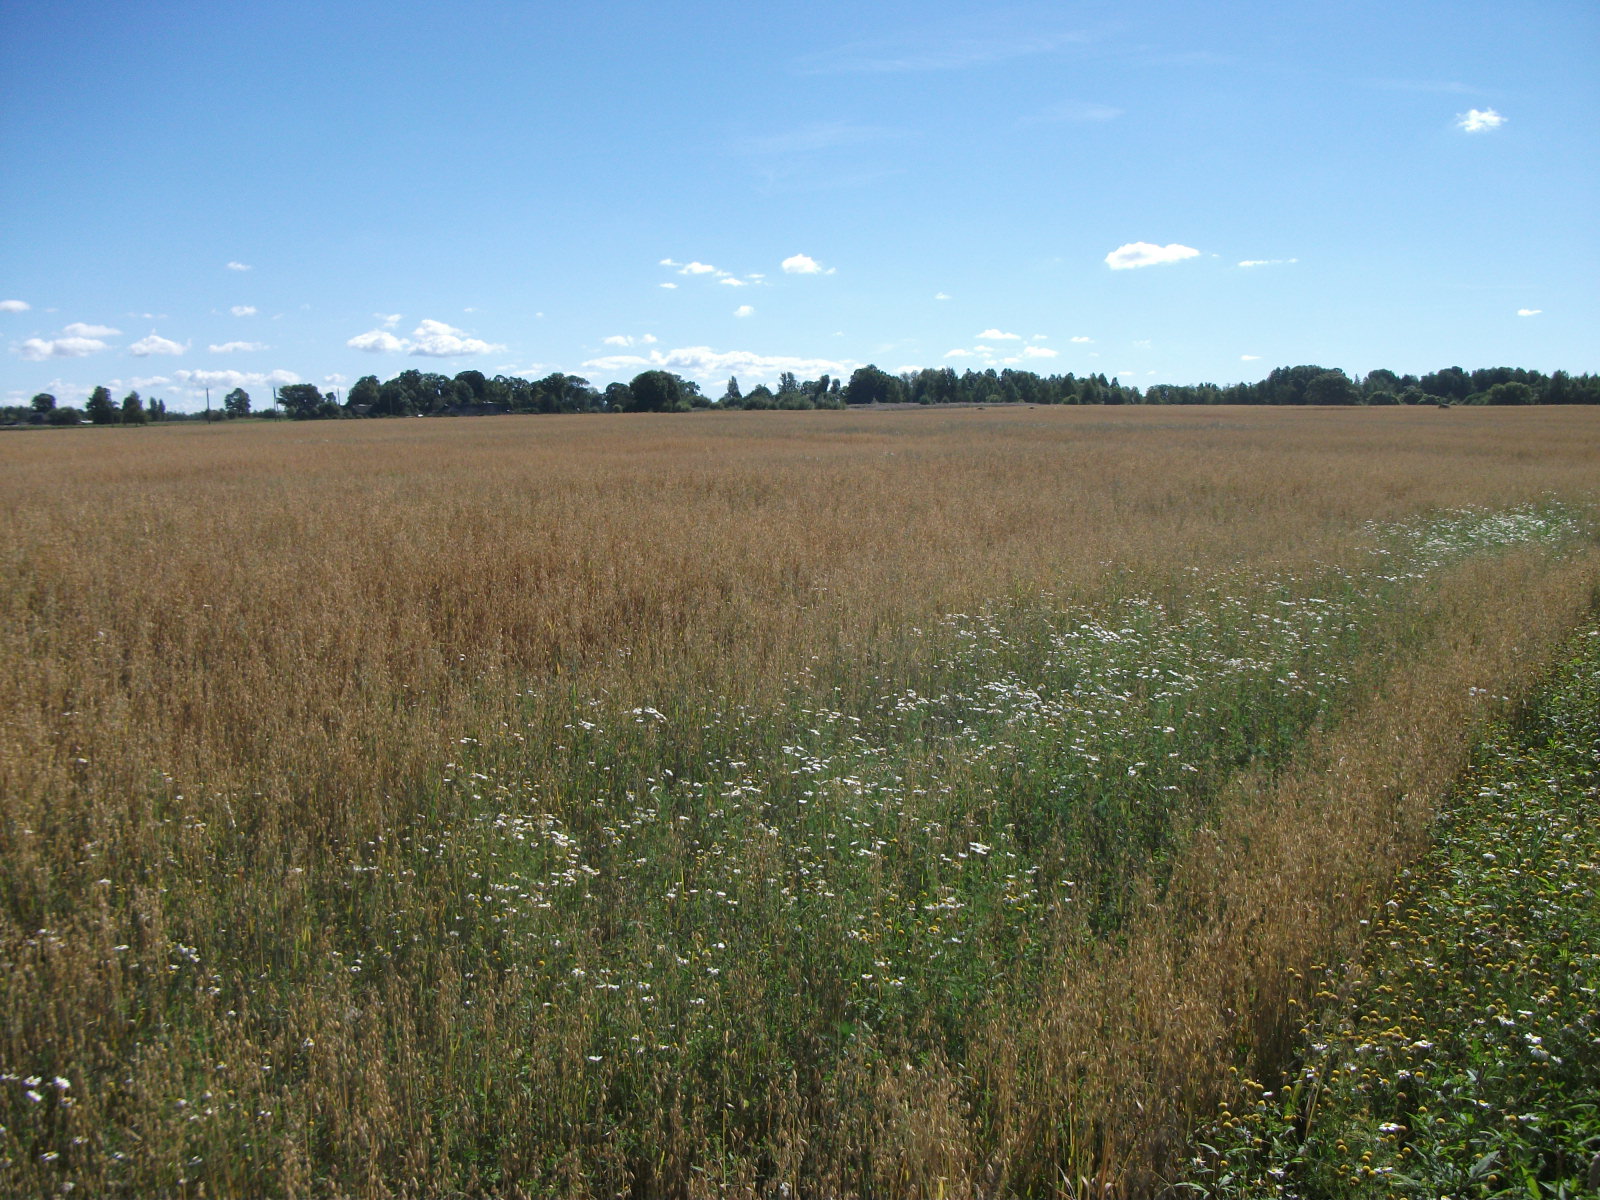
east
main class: Cropland
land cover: Common wheat
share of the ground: > 75 %
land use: Agriculture (excluding fallow land and kitchen gardens)
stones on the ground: < 10 %
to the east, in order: Common wheat; Electric lines; Common wheat; Oats
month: August
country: LV
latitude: 56.6913
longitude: 26.3561
